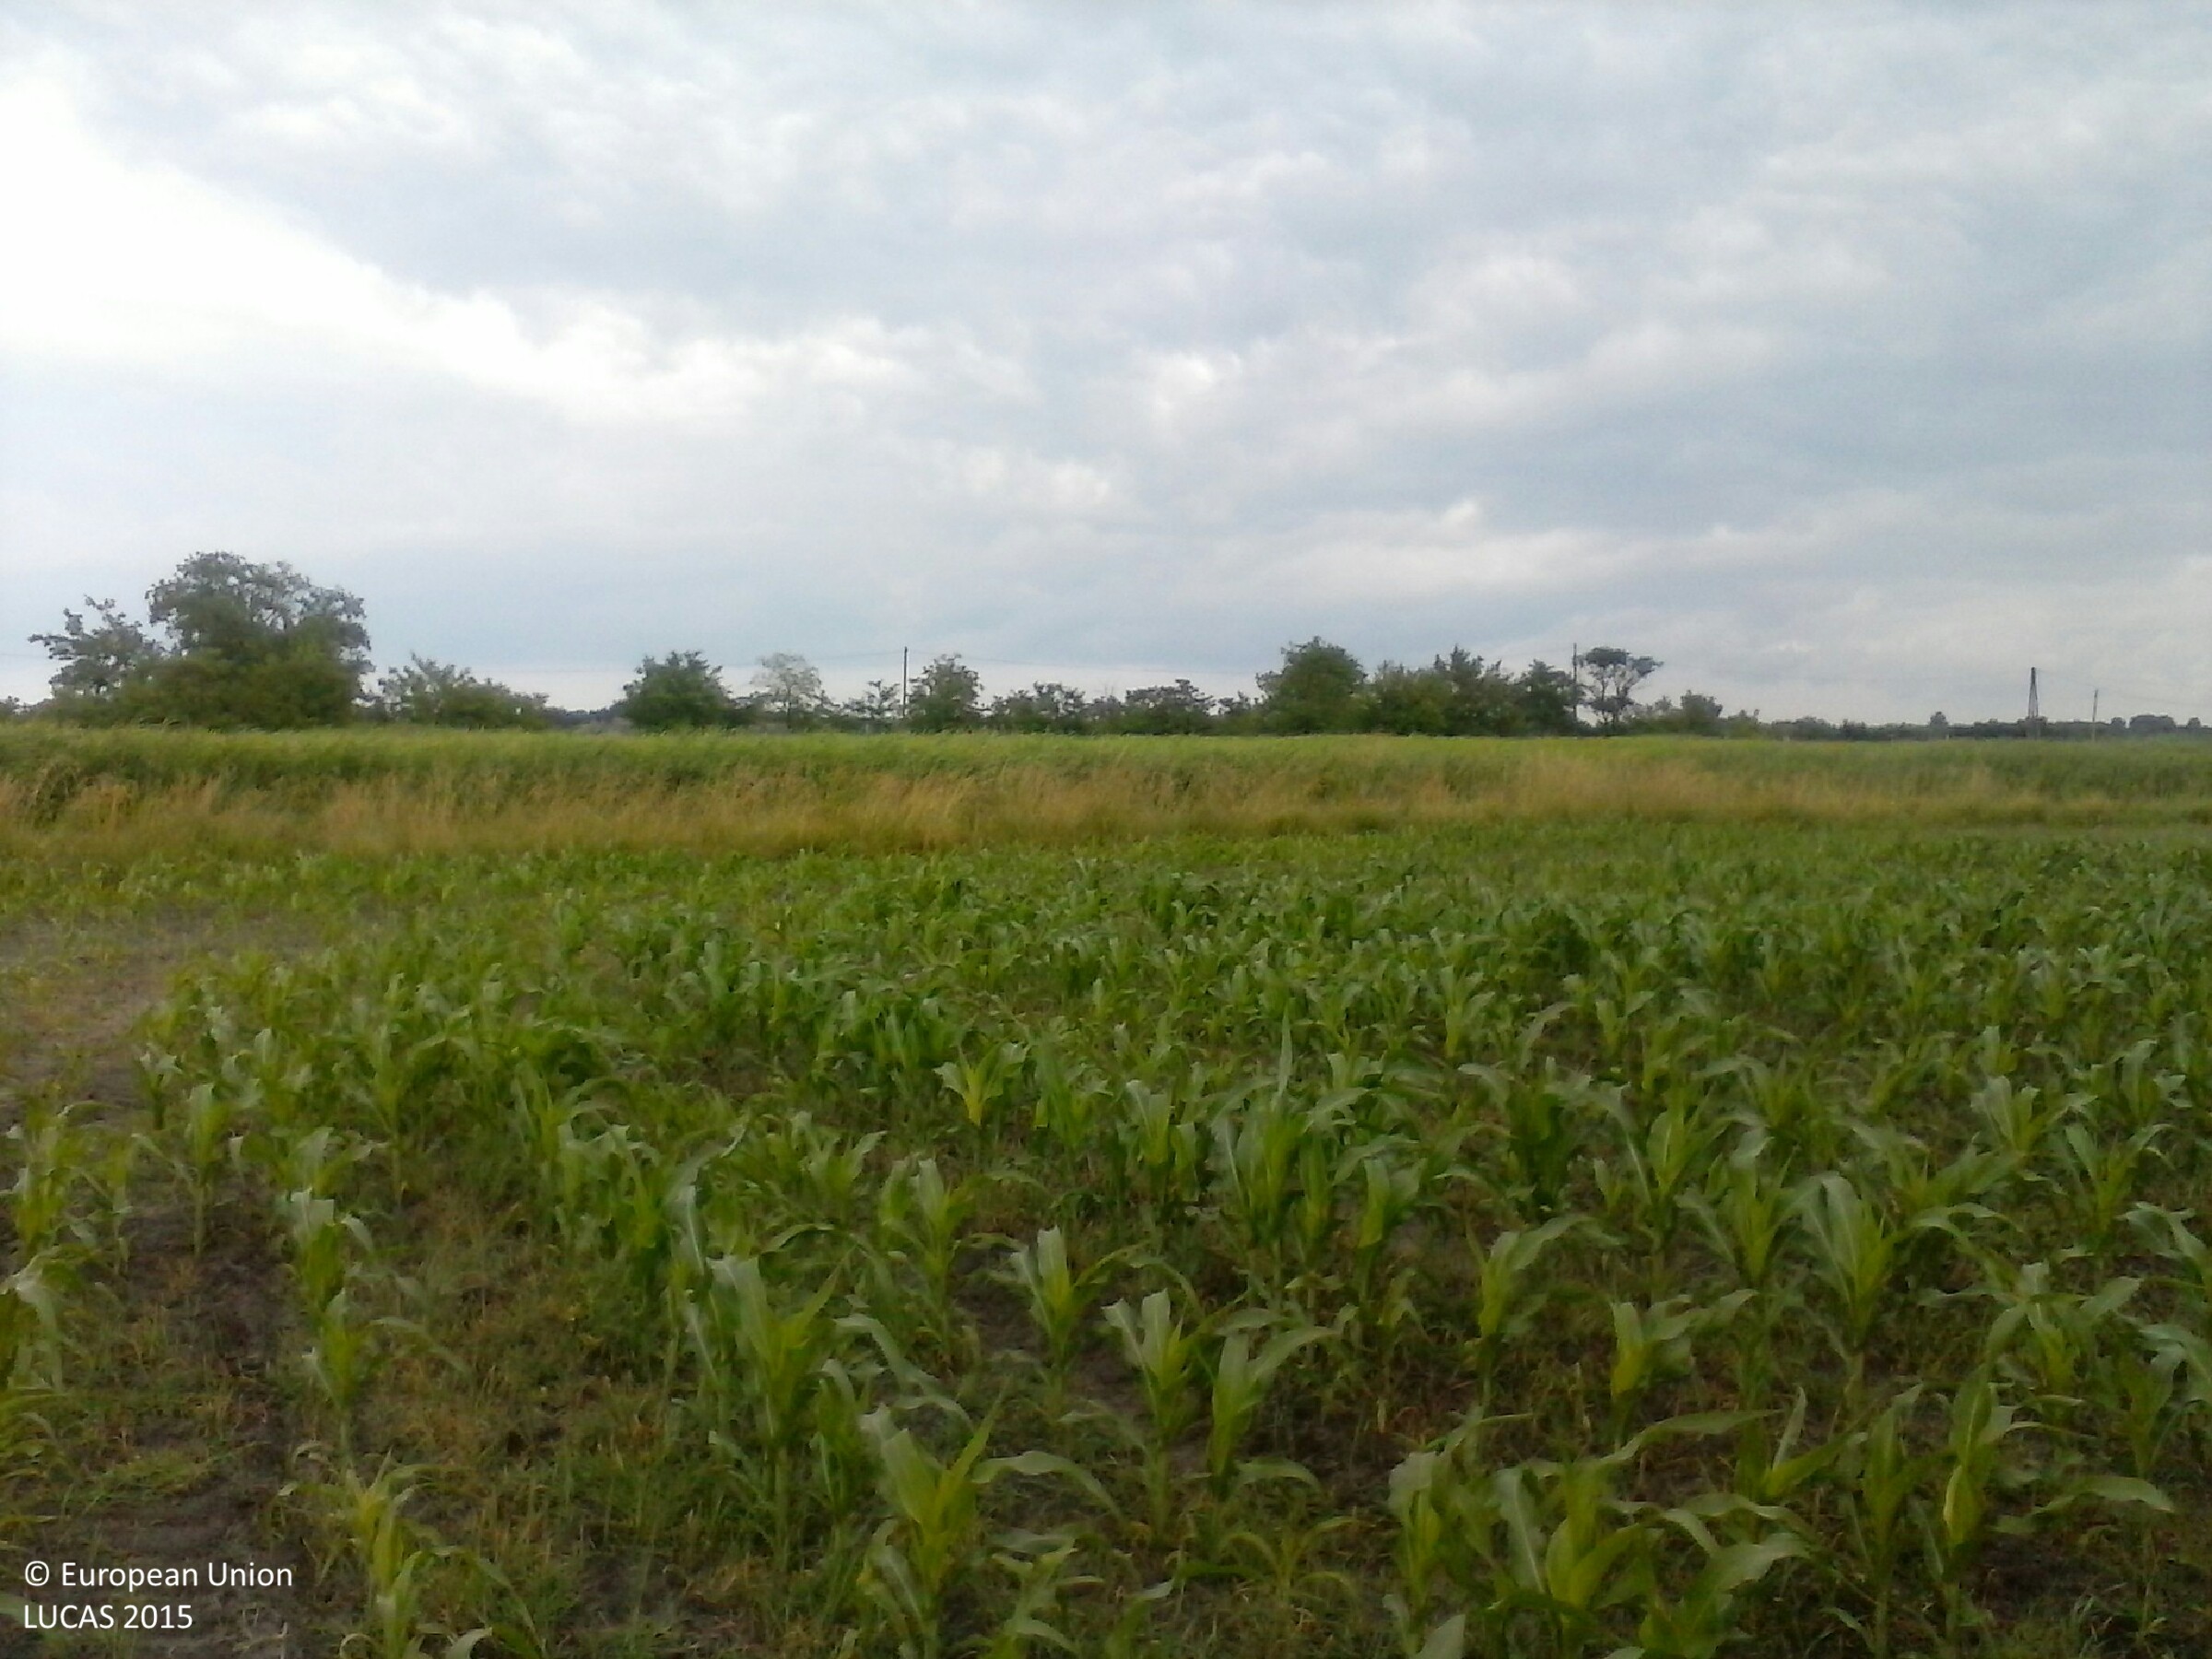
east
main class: Cropland
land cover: Maize
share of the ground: 50 - 75 %
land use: Agriculture (excluding fallow land and kitchen gardens)
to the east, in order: Maize; Grass margins; Inland marshes; Ditches and canals; Lines of trees; Grass margins; Paved roads, cycling and walking lanes; Grass margins; Fences; Electric lines; Grassland without tree/shrub cover; Fences; Grass margins; Tracks; Grass margins; Ditches and canals; Grass margins; Tracks; Grass margins; Fences; Grassland without tree/shrub cover
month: June
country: HU
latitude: 46.4029
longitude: 20.0502
